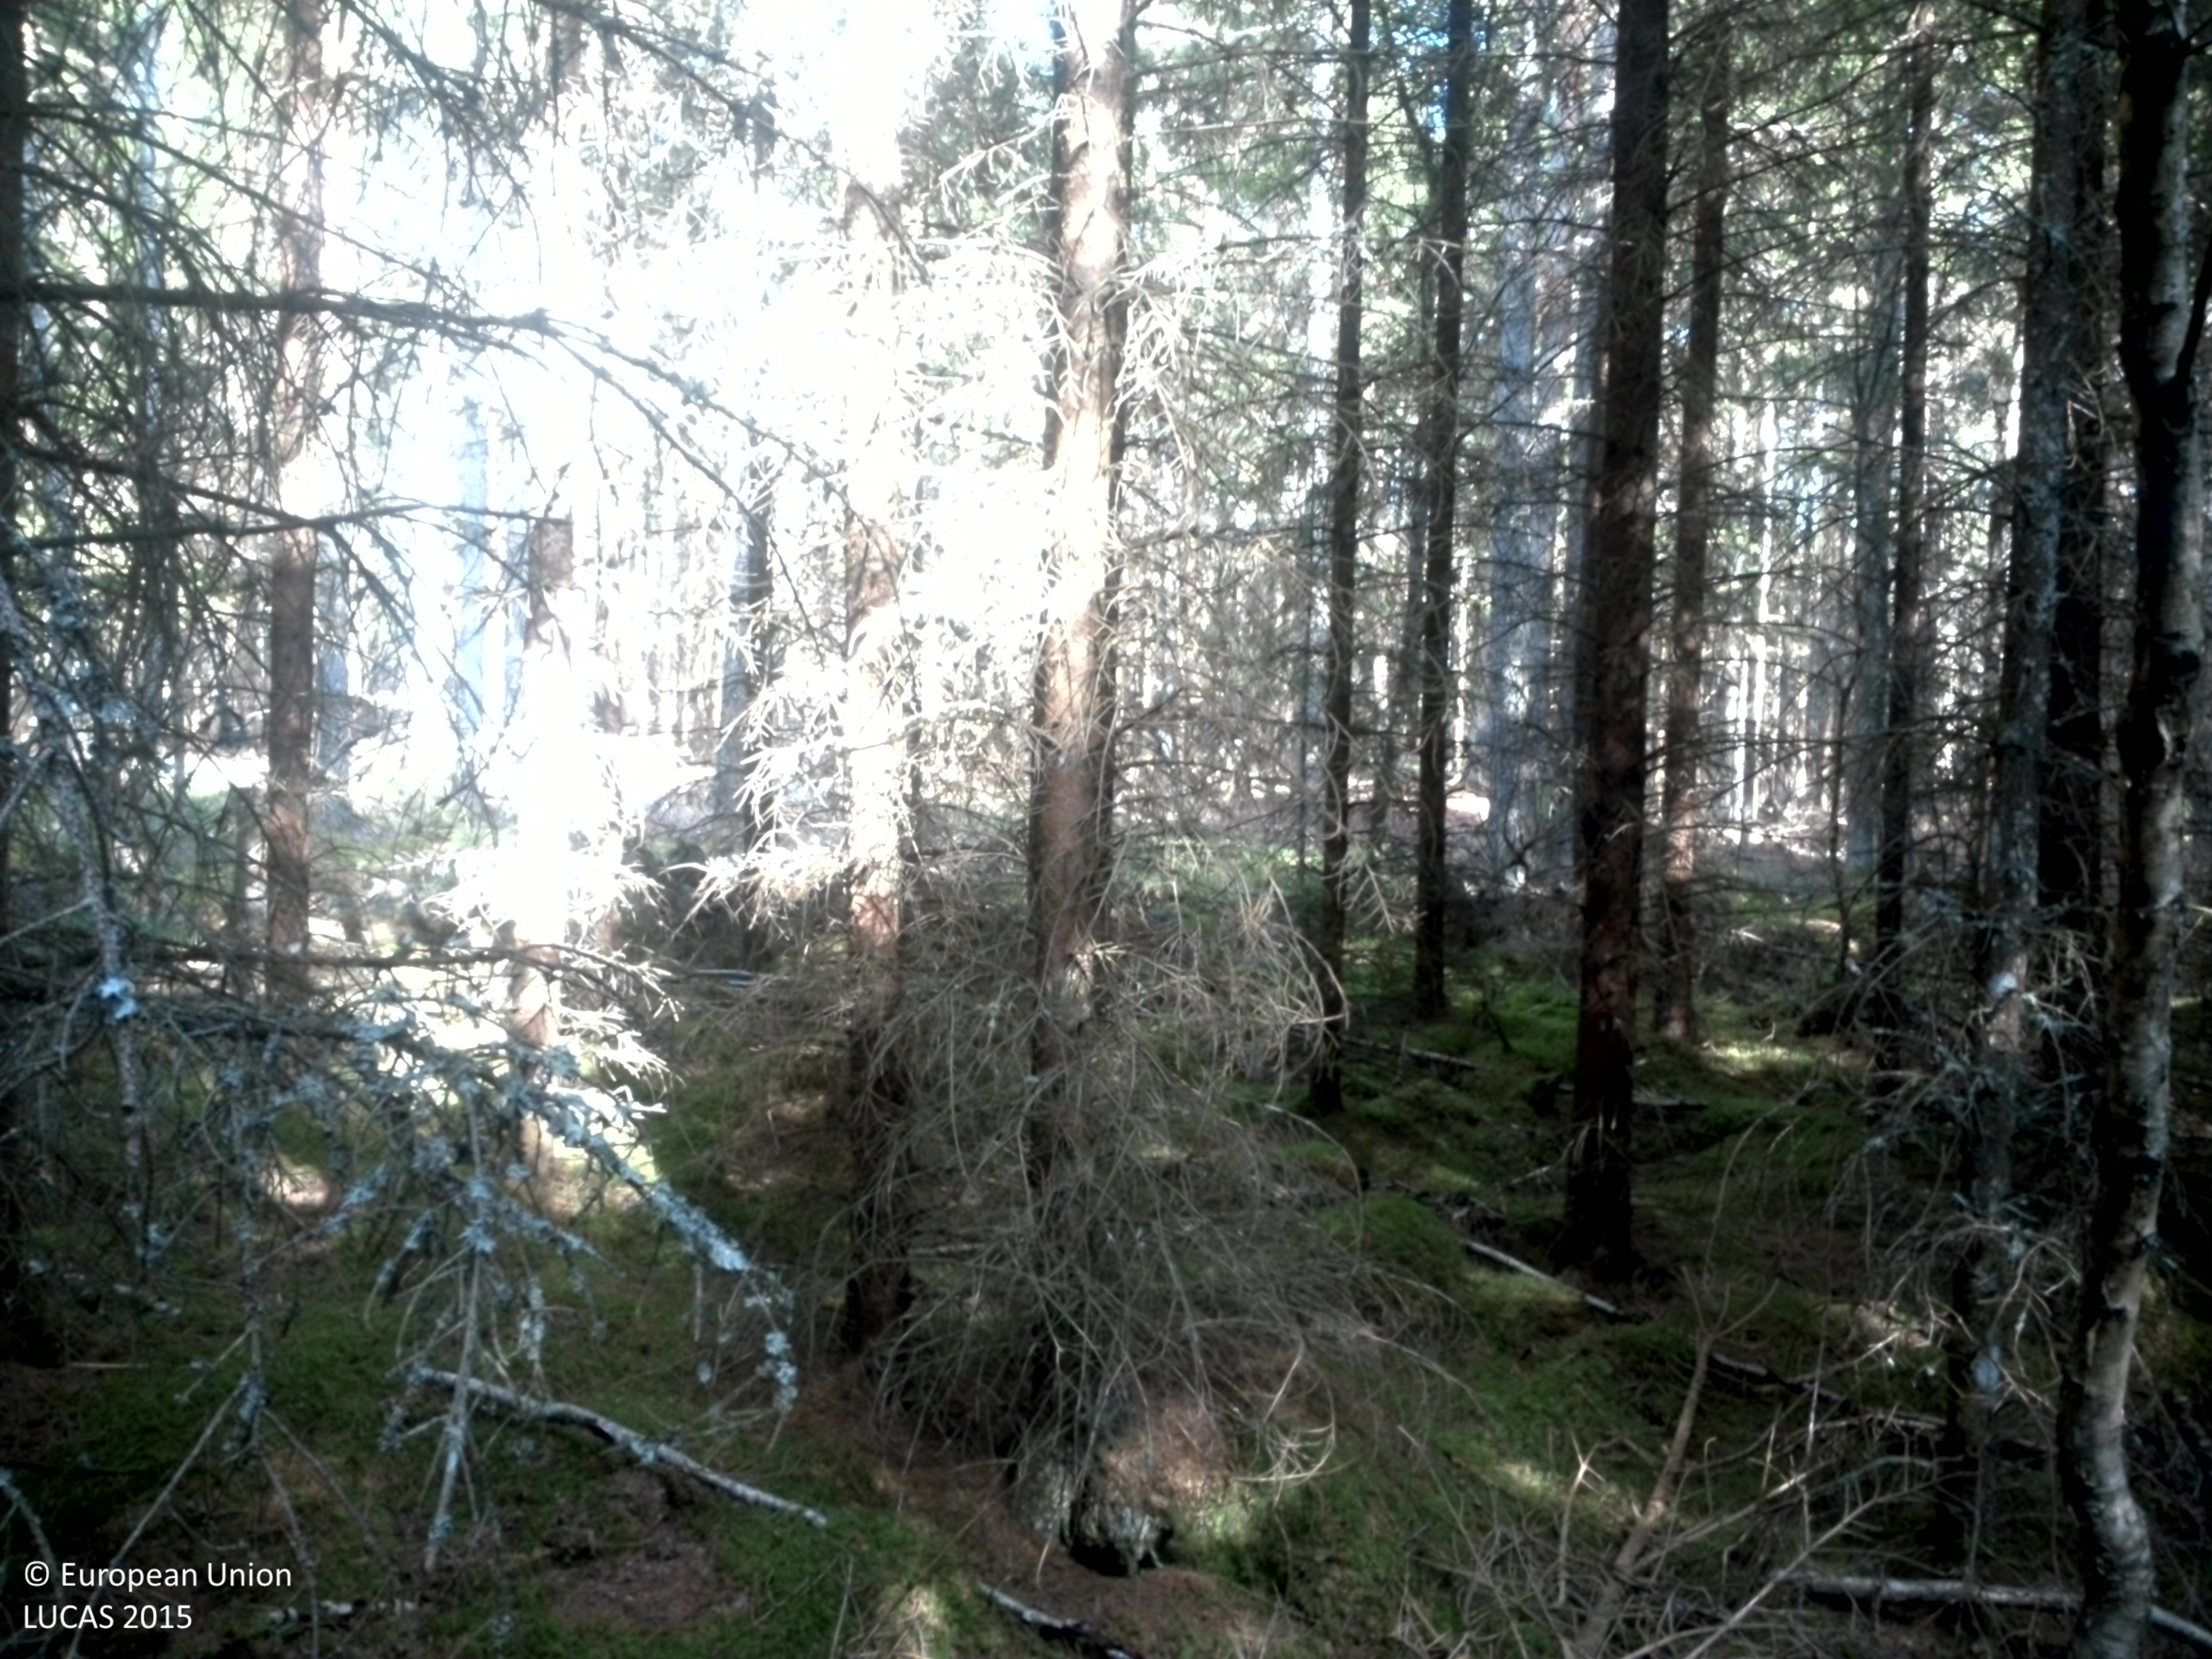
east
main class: Woodland
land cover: Spruce dominated coniferous woodland
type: boreal forest
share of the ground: 50 - 75 %
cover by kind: coniferous forest trees 70 %, lichens and mosses 25 %, herbaceous plants 5 %
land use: Forestry
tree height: > 5 m
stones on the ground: < 10 %
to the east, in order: Spruce dominated coniferous woodland; Dry stone walls; Pine dominated coniferous woodland; Spruce dominated coniferous woodland; Tracks; Spruce dominated coniferous woodland; Paved roads, cycling and walking lanes; Spruce dominated coniferous woodland
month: August
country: SE
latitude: 58.1608
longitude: 13.3087
